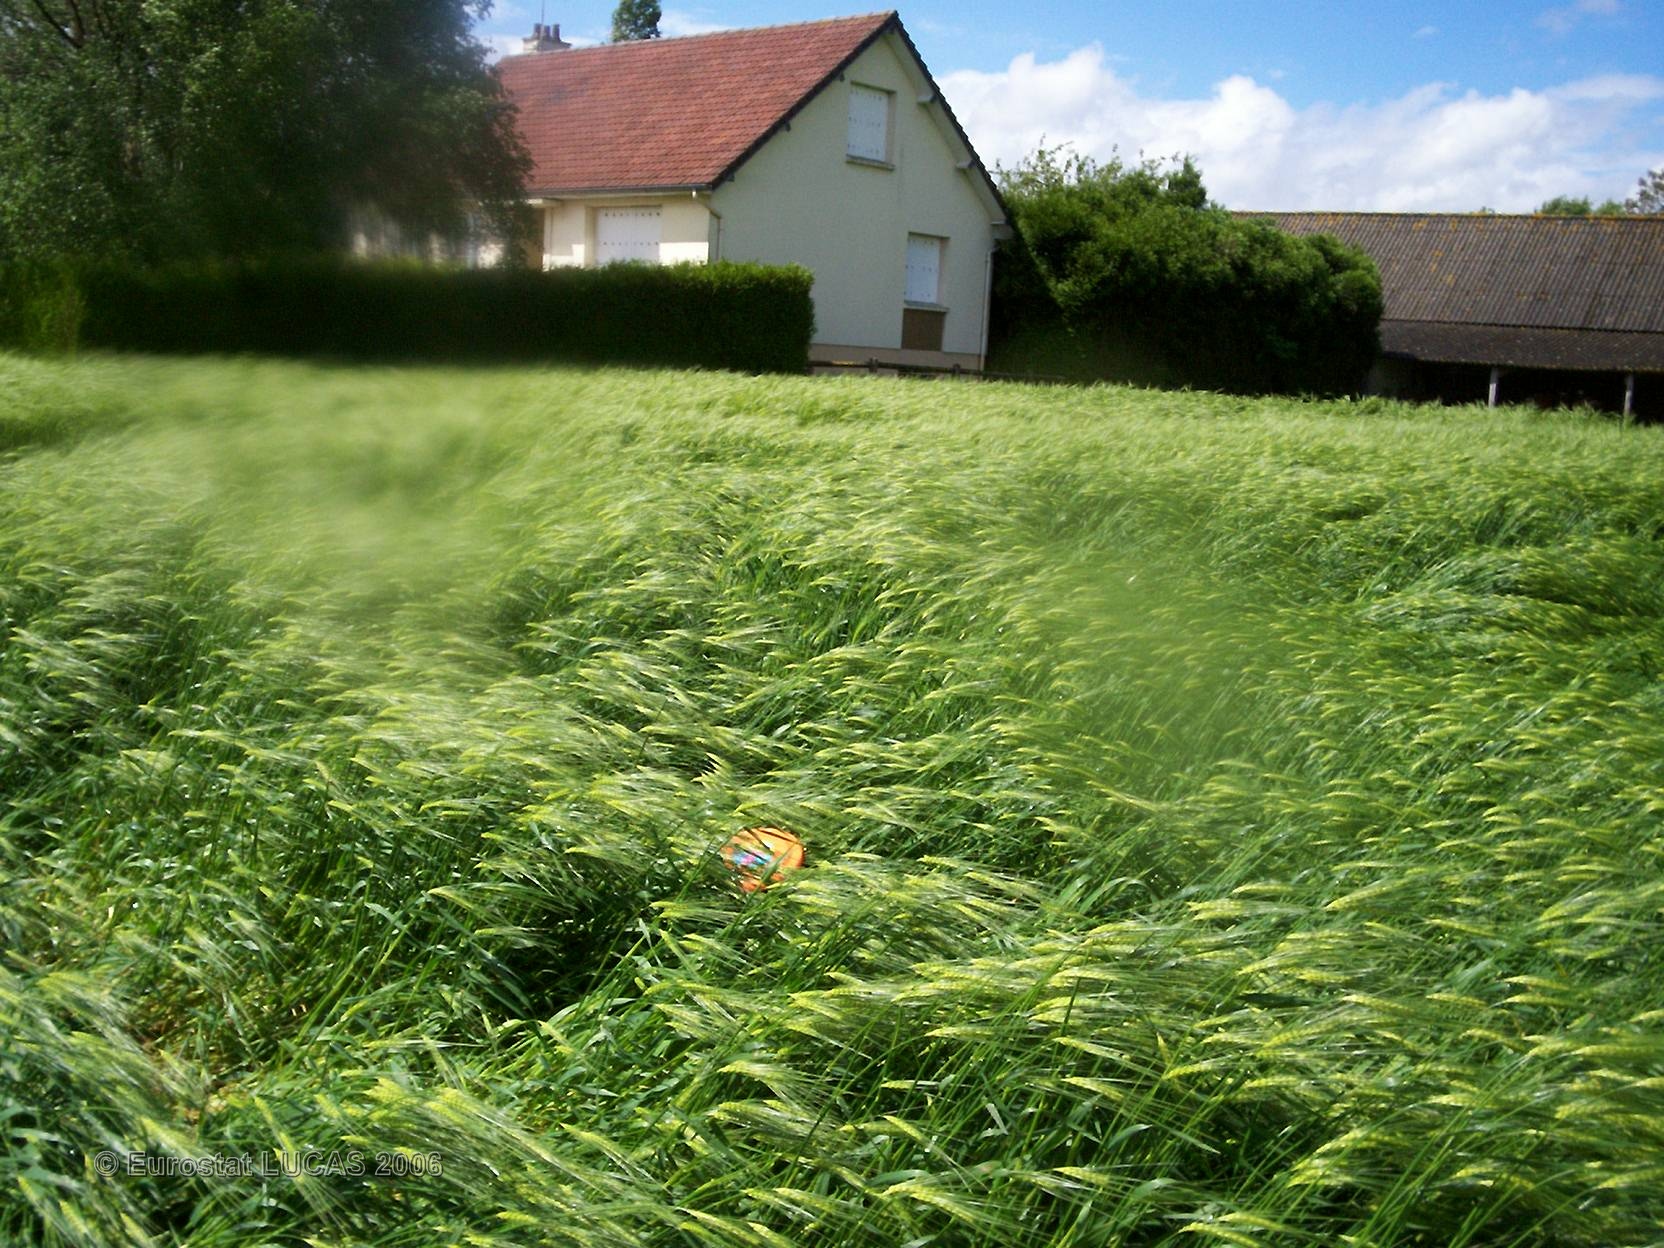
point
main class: Cropland
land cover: Barley
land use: Agriculture (excluding fallow land and kitchen gardens)
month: May
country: FR
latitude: 49.5448
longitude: 0.4225
